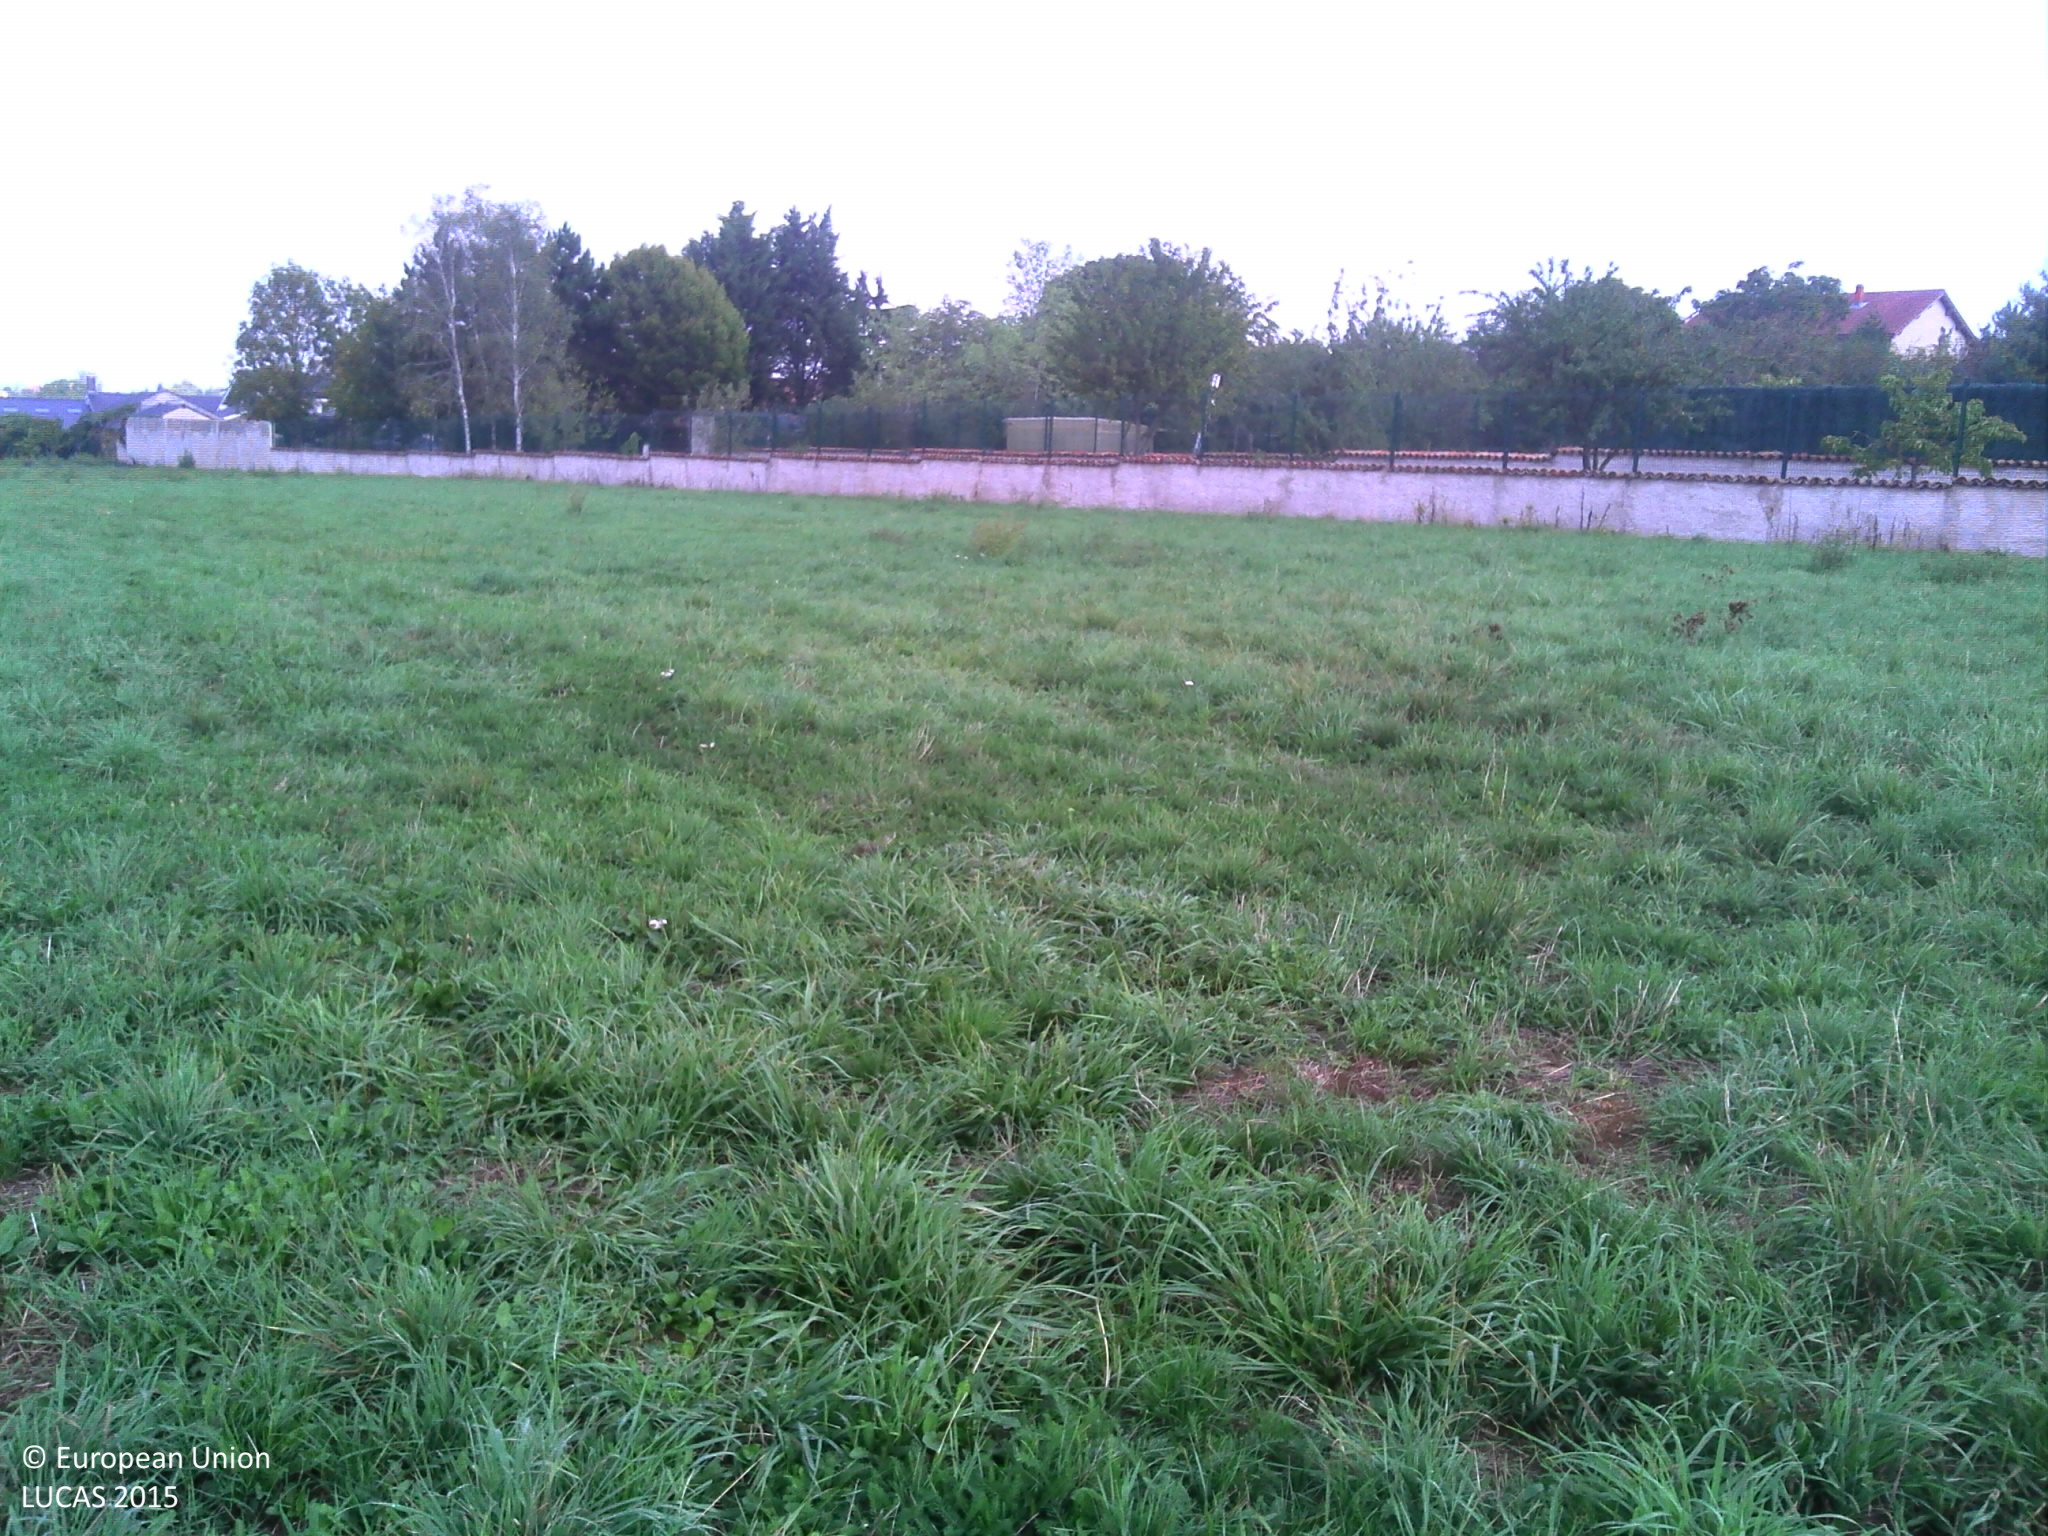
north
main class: Grassland
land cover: Grassland without tree/shrub cover
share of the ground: > 75 %
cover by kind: herbaceous plants 95 %, consolidated bare surface 5 %
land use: Agriculture (excluding fallow land and kitchen gardens)
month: September
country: FR
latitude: 49.1581
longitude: 5.9543
